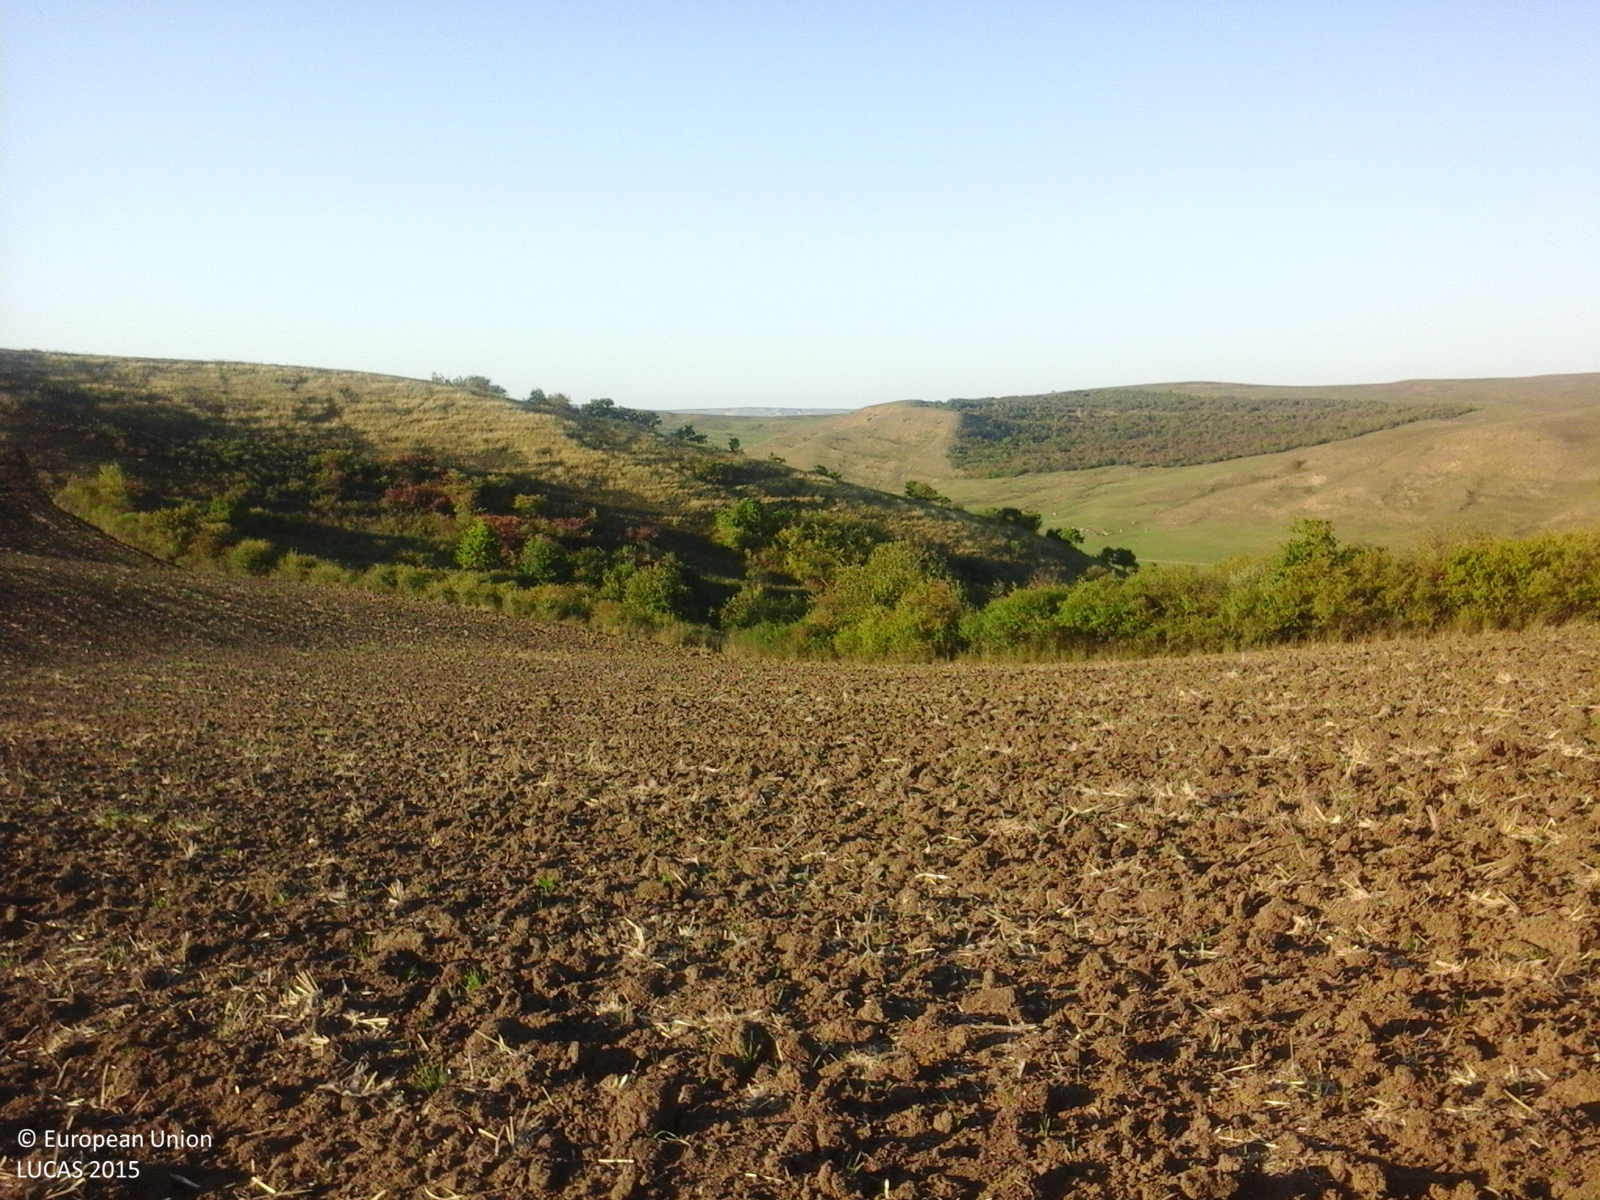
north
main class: Cropland
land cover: Common wheat
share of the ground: < 10 %
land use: Agriculture (excluding fallow land and kitchen gardens)
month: October
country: RO
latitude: 46.1775
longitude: 23.9737
